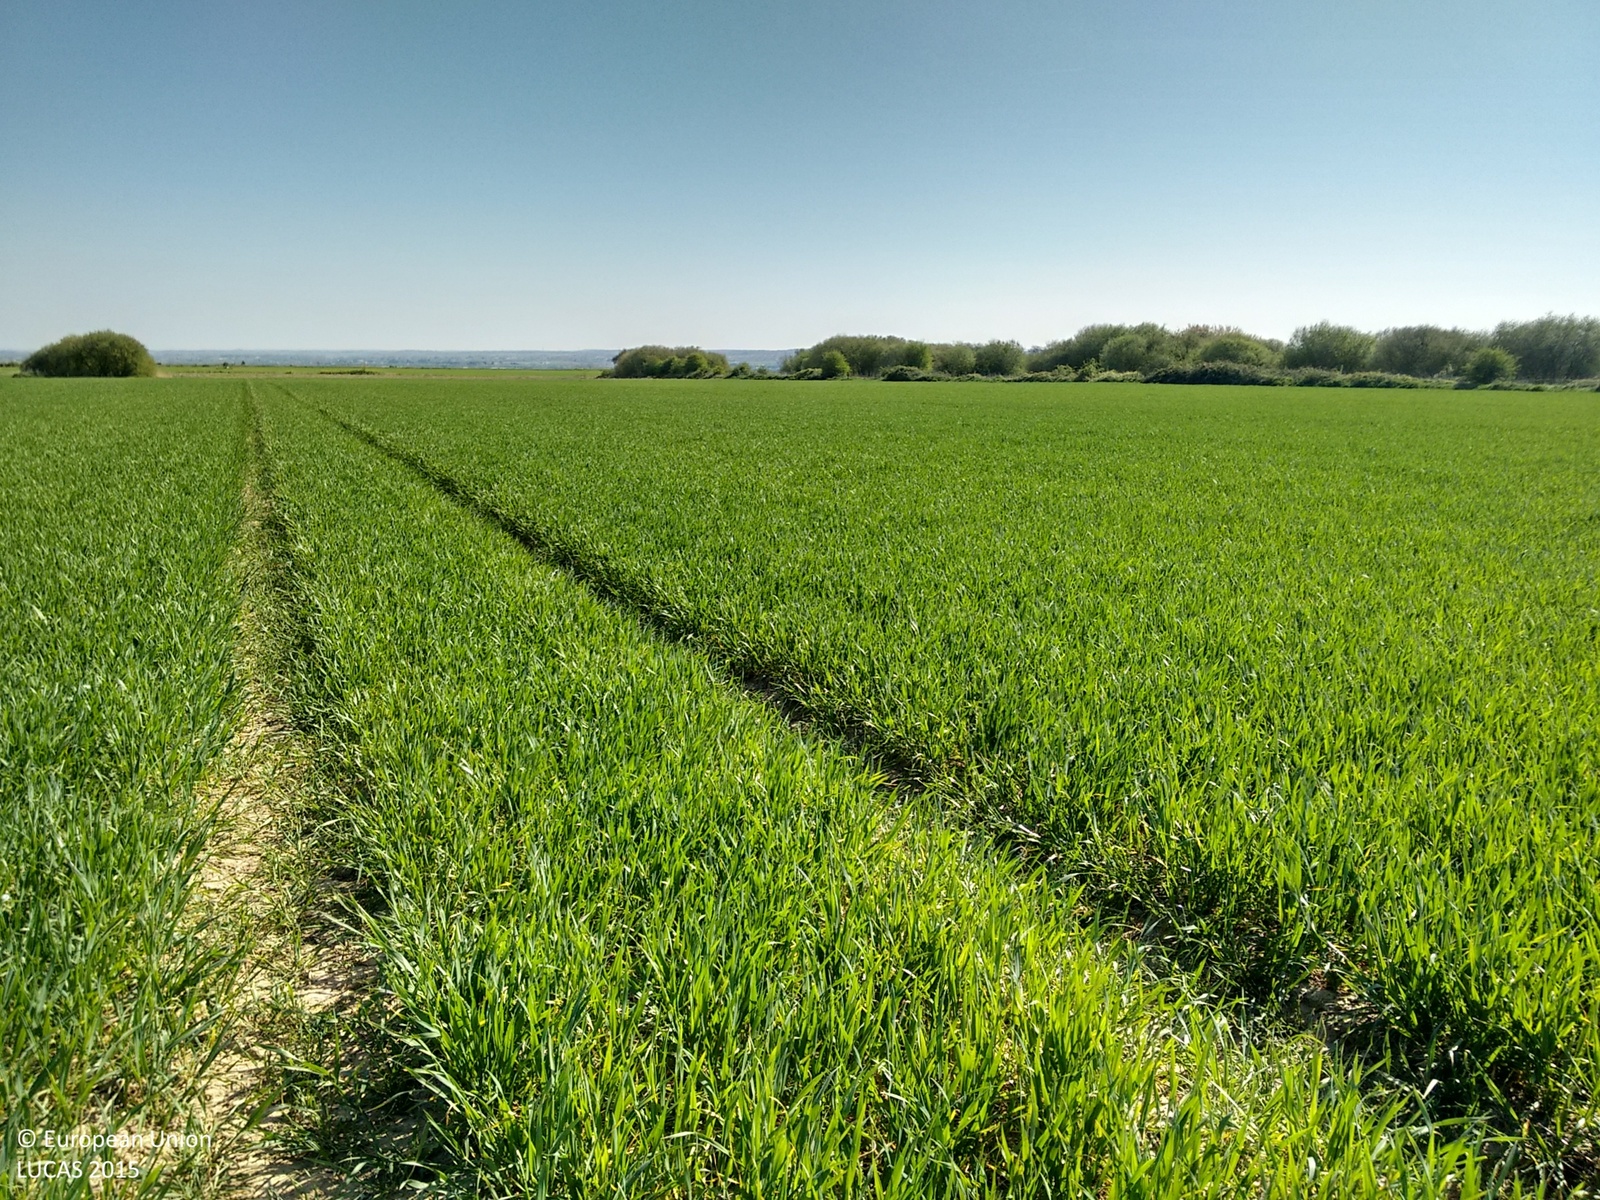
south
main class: Cropland
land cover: Common wheat
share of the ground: > 75 %
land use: Agriculture (excluding fallow land and kitchen gardens)
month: April
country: GB
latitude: 51.4230
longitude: 0.5820
